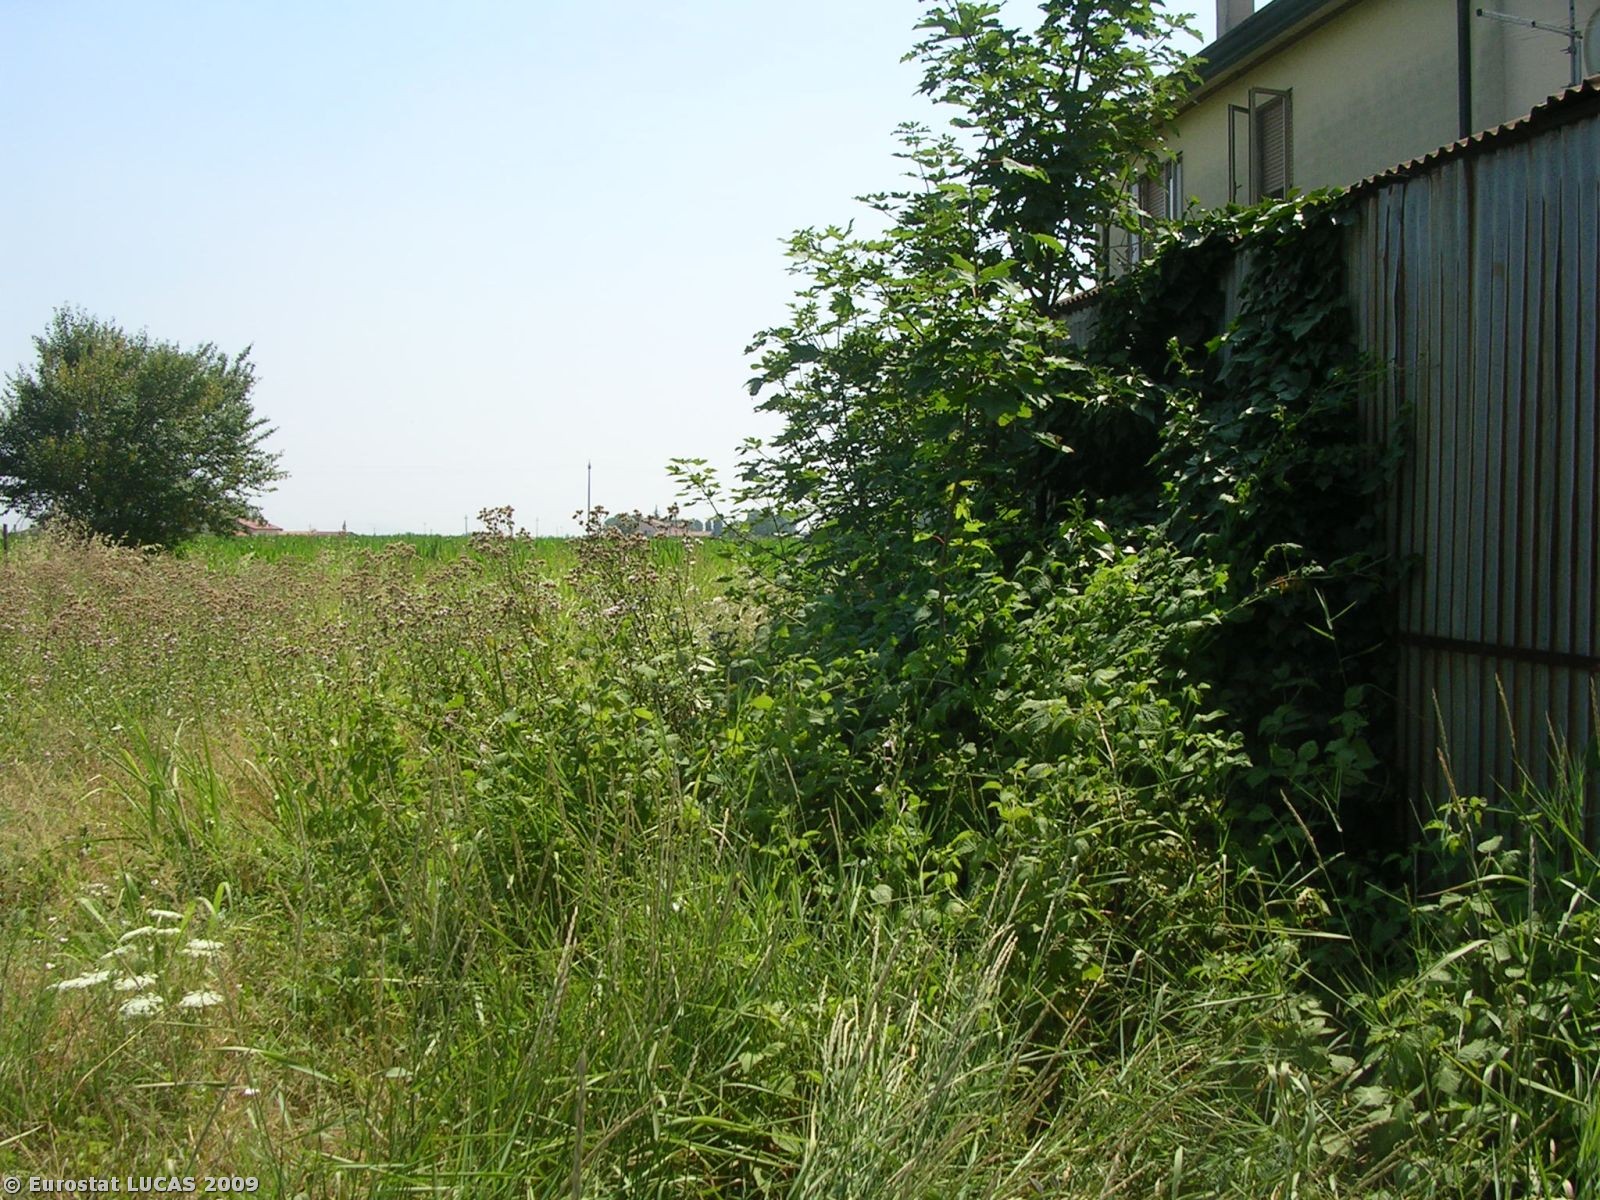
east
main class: Grassland
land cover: Spontaneously vegetated surfaces
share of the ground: > 75 %
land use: Residential
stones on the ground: < 10 %
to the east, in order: Spontaneously vegetated surfaces; Maize; Grass margins; Ditches and canals; Grass margins; Maize; Grass margins; Ditches and canals; Grass margins; Maize
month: June
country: IT
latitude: 45.1480
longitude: 11.7139
